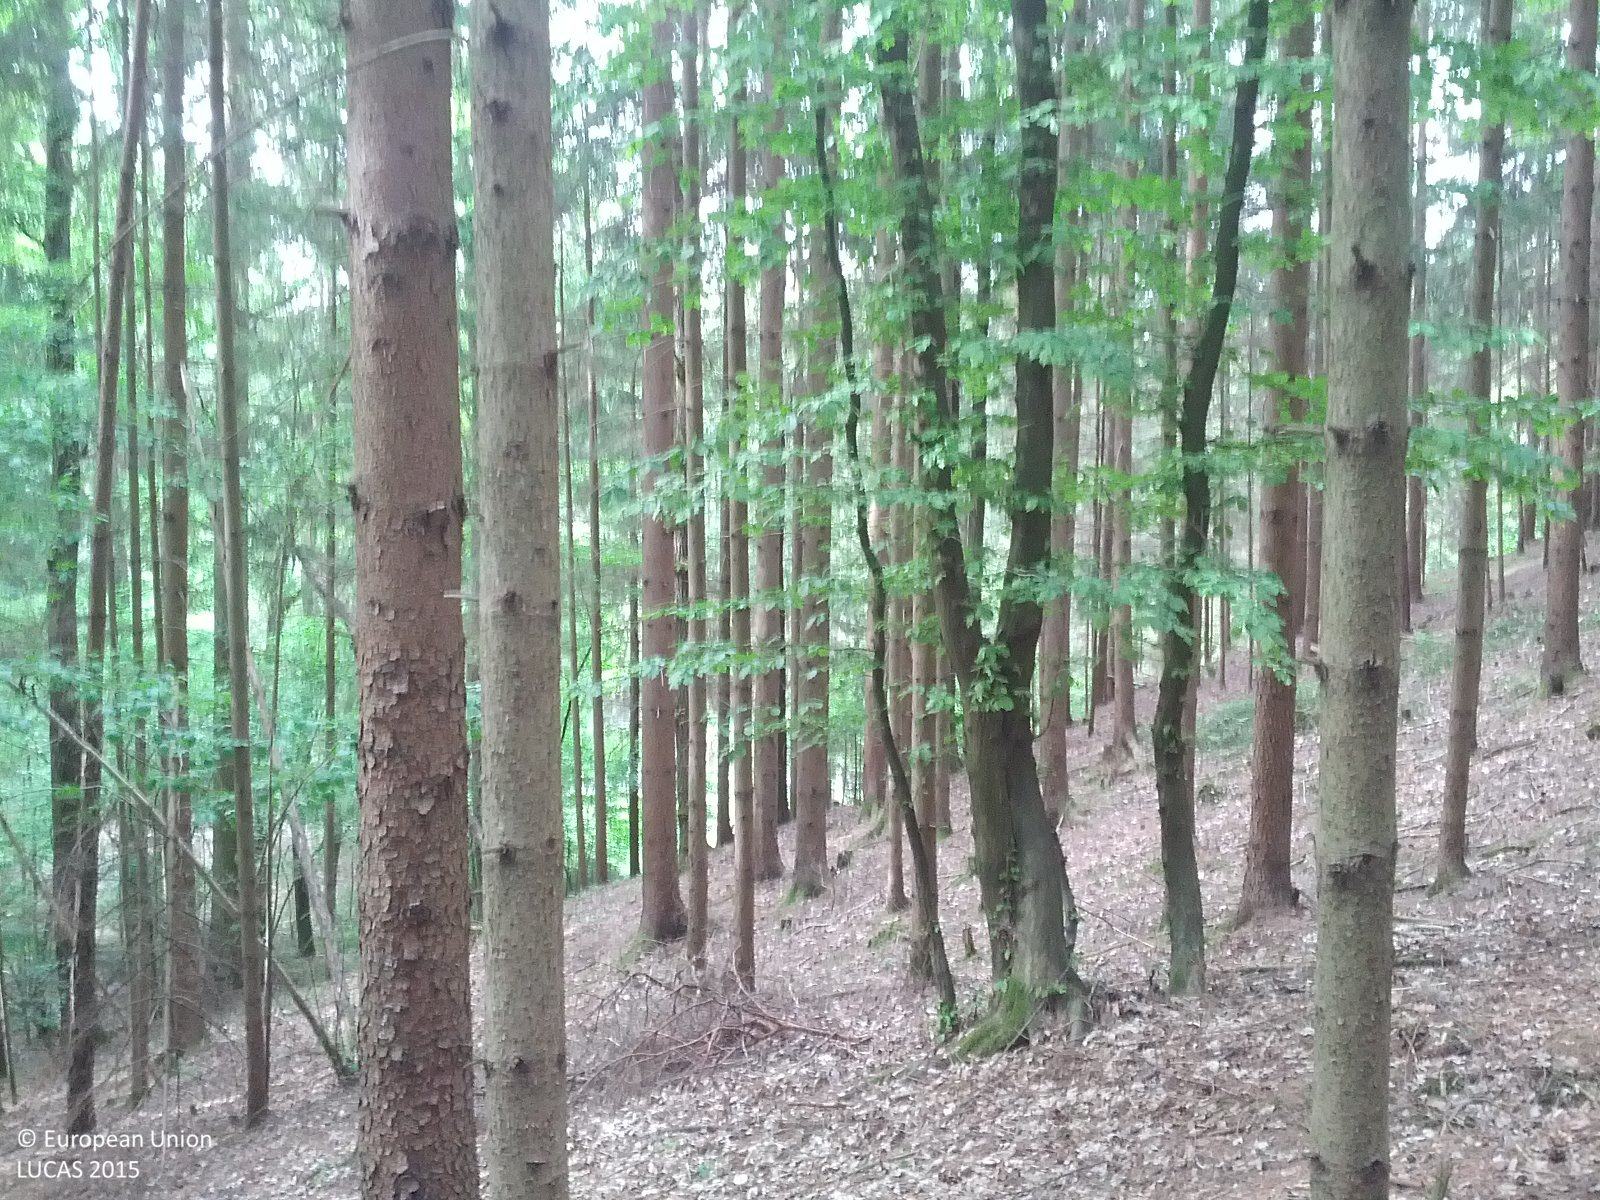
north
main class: Woodland
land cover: Spruce dominated coniferous woodland
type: hemiboreal forest and nemoral coniferous forest and mixed broadleaved-coniferous forest
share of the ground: > 75 %
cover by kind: coniferous forest trees 90 %, broadleaved forest trees 5 %, herbaceous plants 5 %
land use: Forestry
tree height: > 5 m
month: May
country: AT
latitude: 47.3699
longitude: 16.0805
